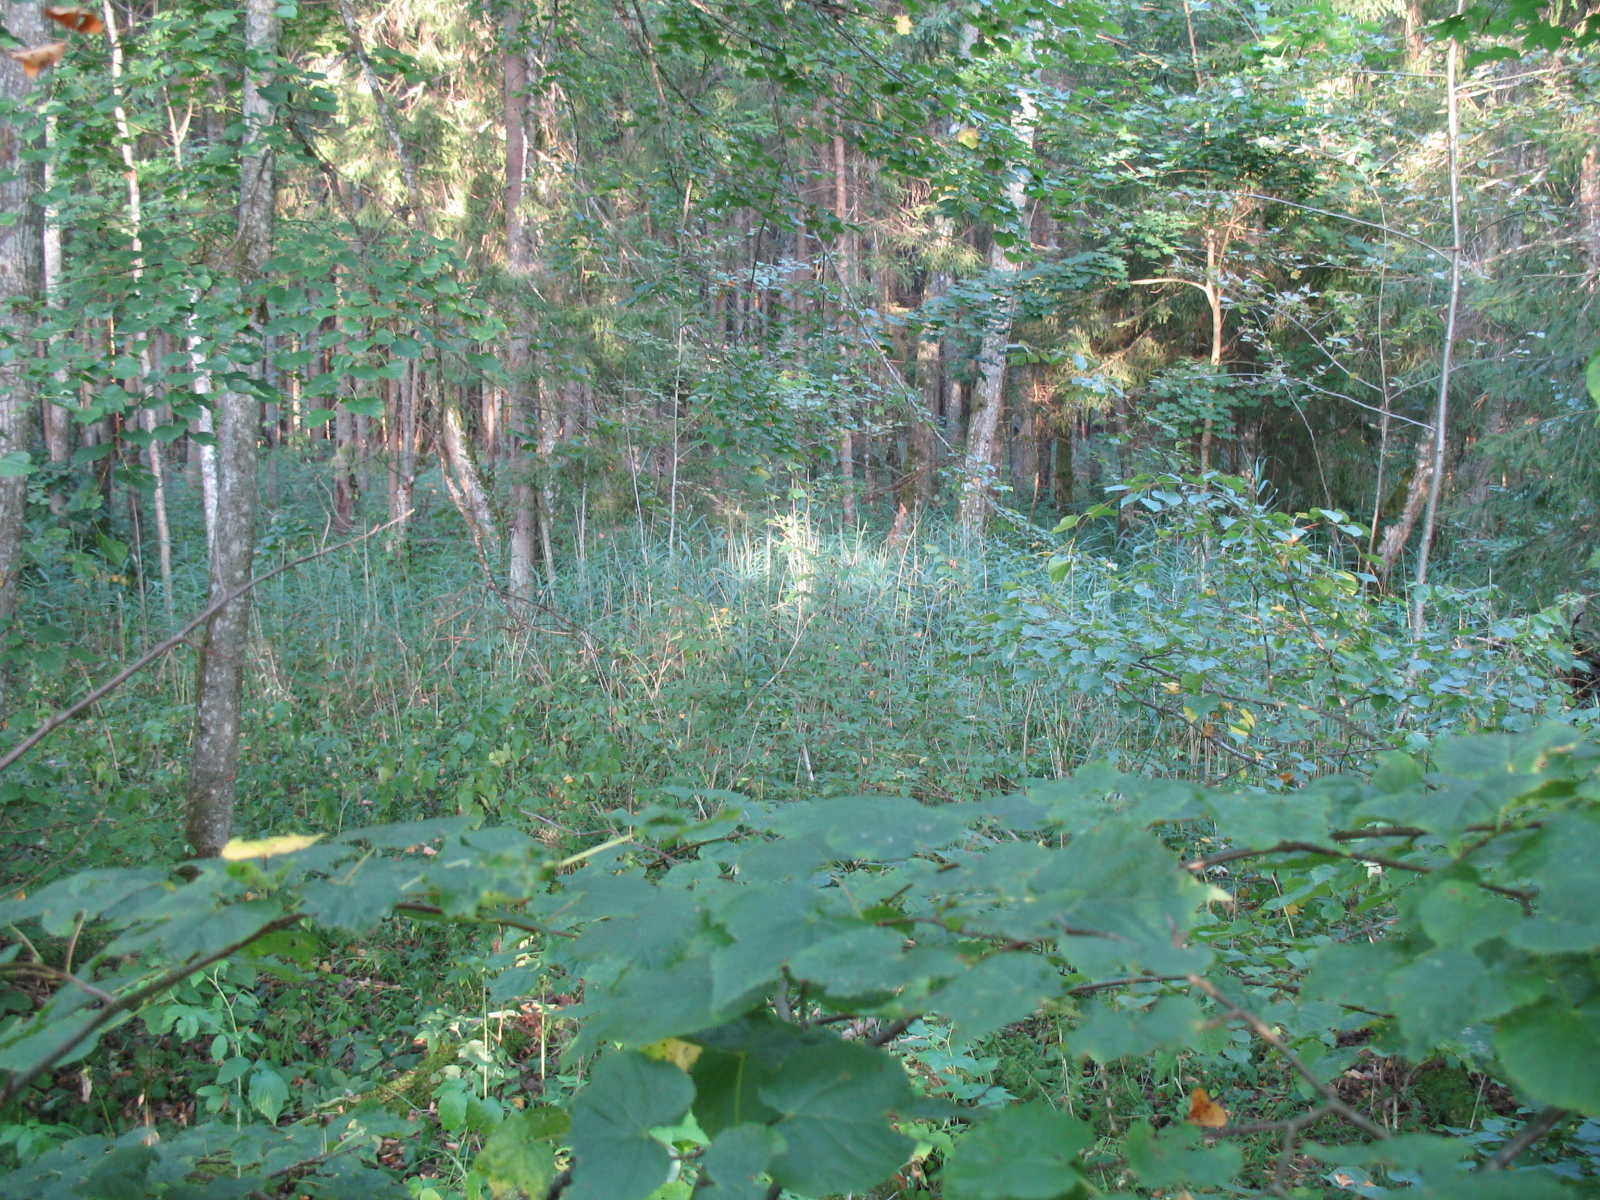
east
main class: Woodland
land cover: Broadleaved woodland
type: non-riverine alder, birch or aspen forest
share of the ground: > 75 %
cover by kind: broadleaved forest trees 85 %, herbaceous plants 15 %
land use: Forestry
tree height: > 5 m
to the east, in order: Broadleaved woodland; Spruce dominated mixed woodland; Spruce dominated coniferous woodland; Spruce dominated mixed woodland; Other coniferous woodland; Spontaneously vegetated surfaces; Ditches and canals; Other mixed woodland
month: August
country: LV
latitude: 56.3840
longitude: 26.0229
